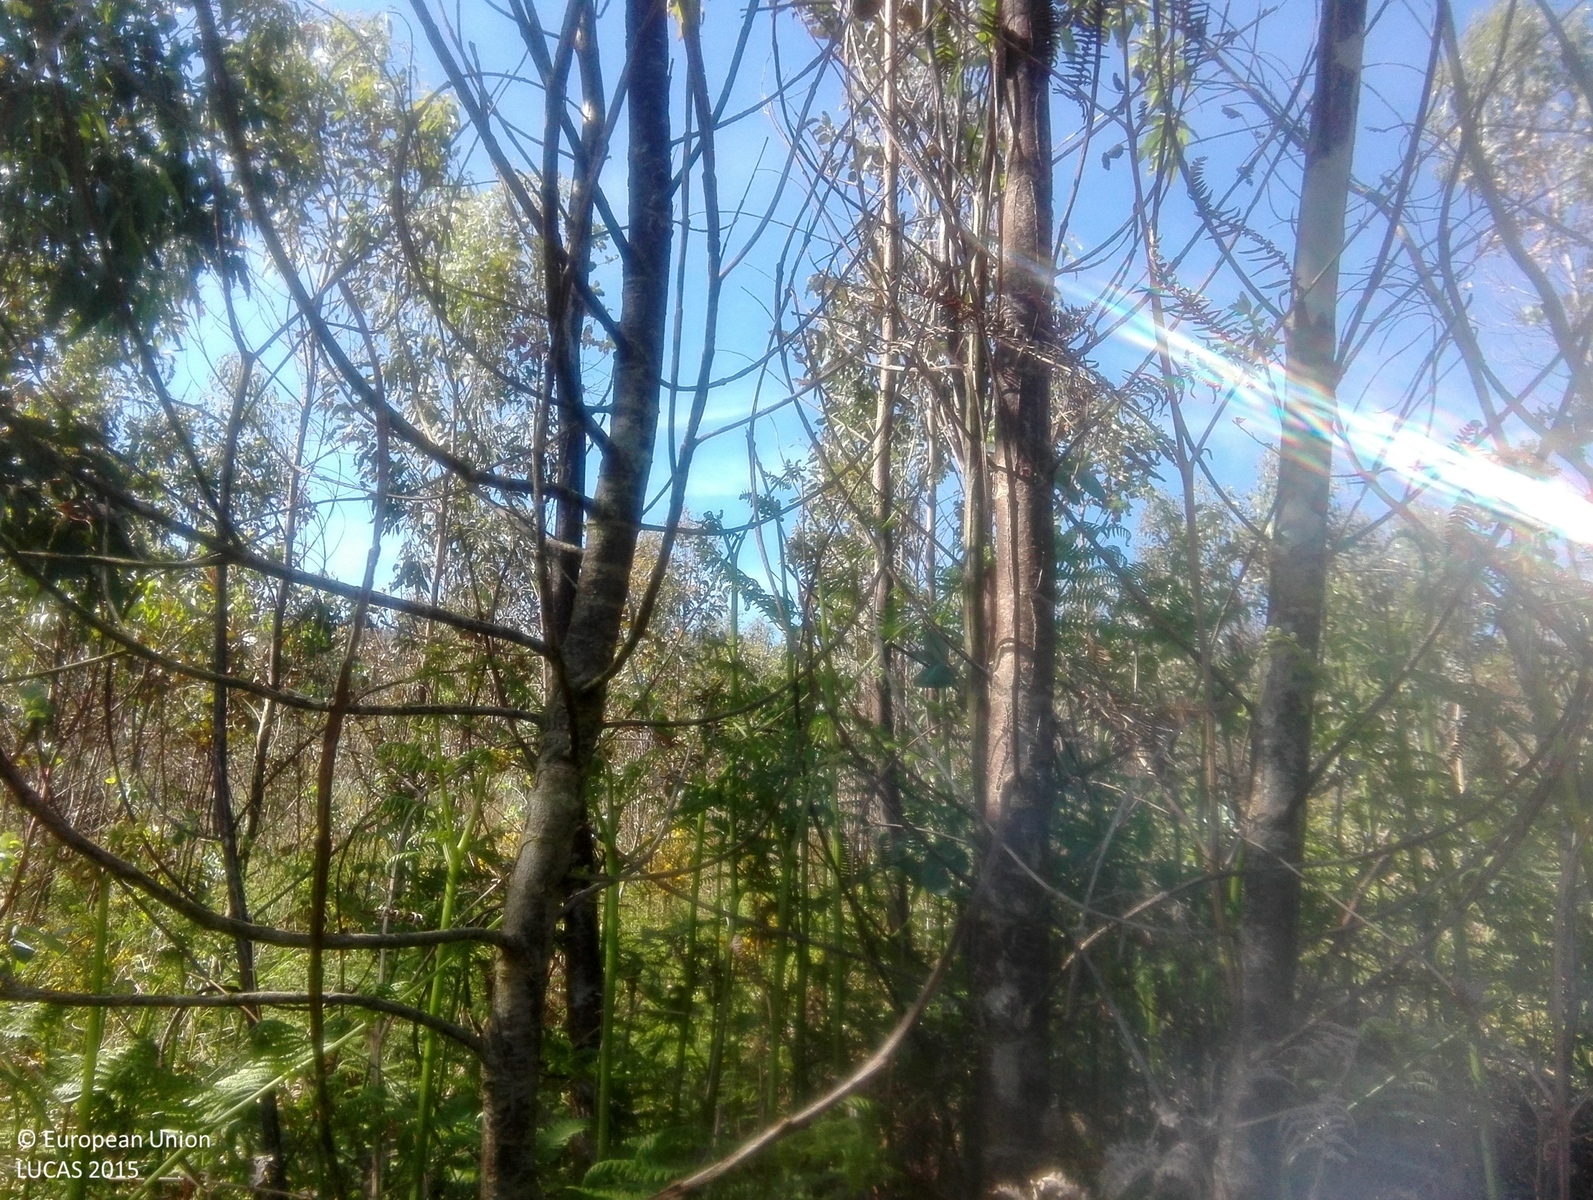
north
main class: Woodland
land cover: Broadleaved woodland
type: exotic forest
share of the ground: 50 - 75 %
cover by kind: broadleaved forest trees 70 %, shrubs 30 %
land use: Forestry
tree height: > 5 m
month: April
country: ES
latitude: 43.4245
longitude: -7.1541
